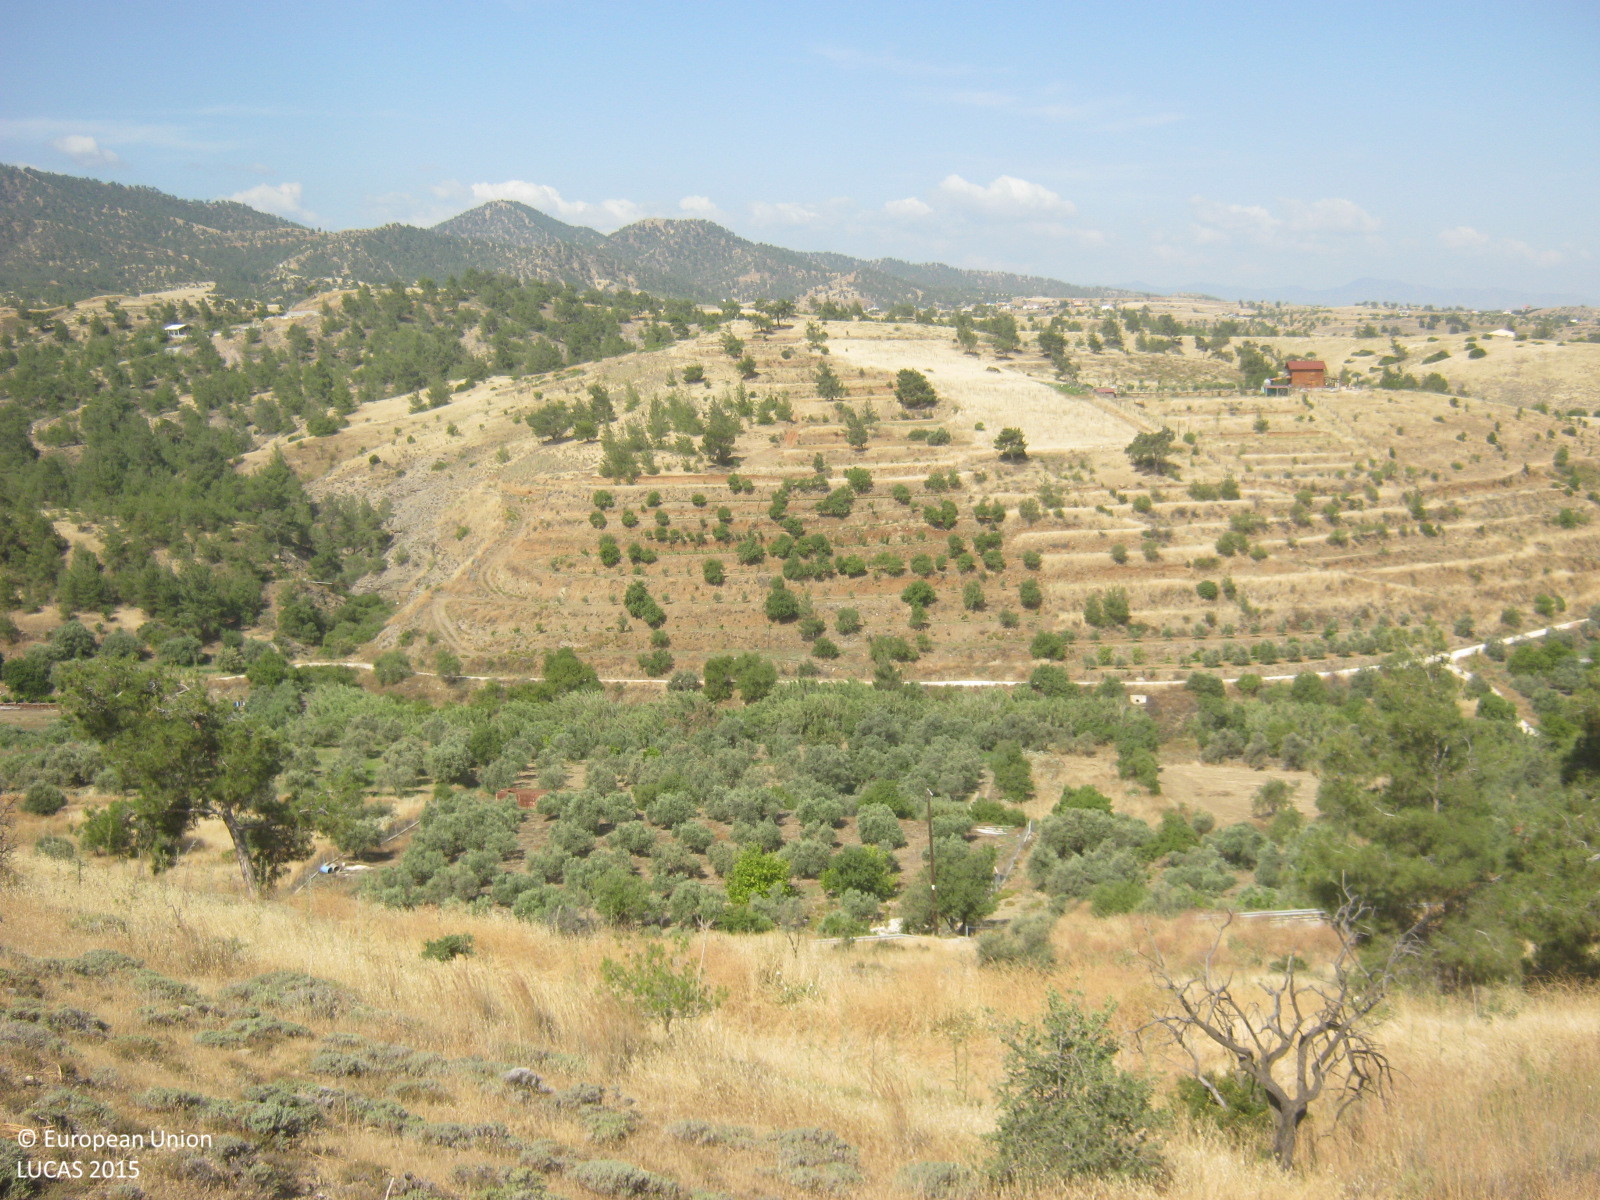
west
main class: Shrubland
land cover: Shrubland without tree cover
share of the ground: 25 - 50 %
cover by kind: herbaceous plants 55 %, shrubs 35 %, unconsolidated bare surface 10 %
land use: Semi-natural and natural areas not in use
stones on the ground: 25 - 50 %
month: May
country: CY
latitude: 35.0703
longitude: 33.0194
